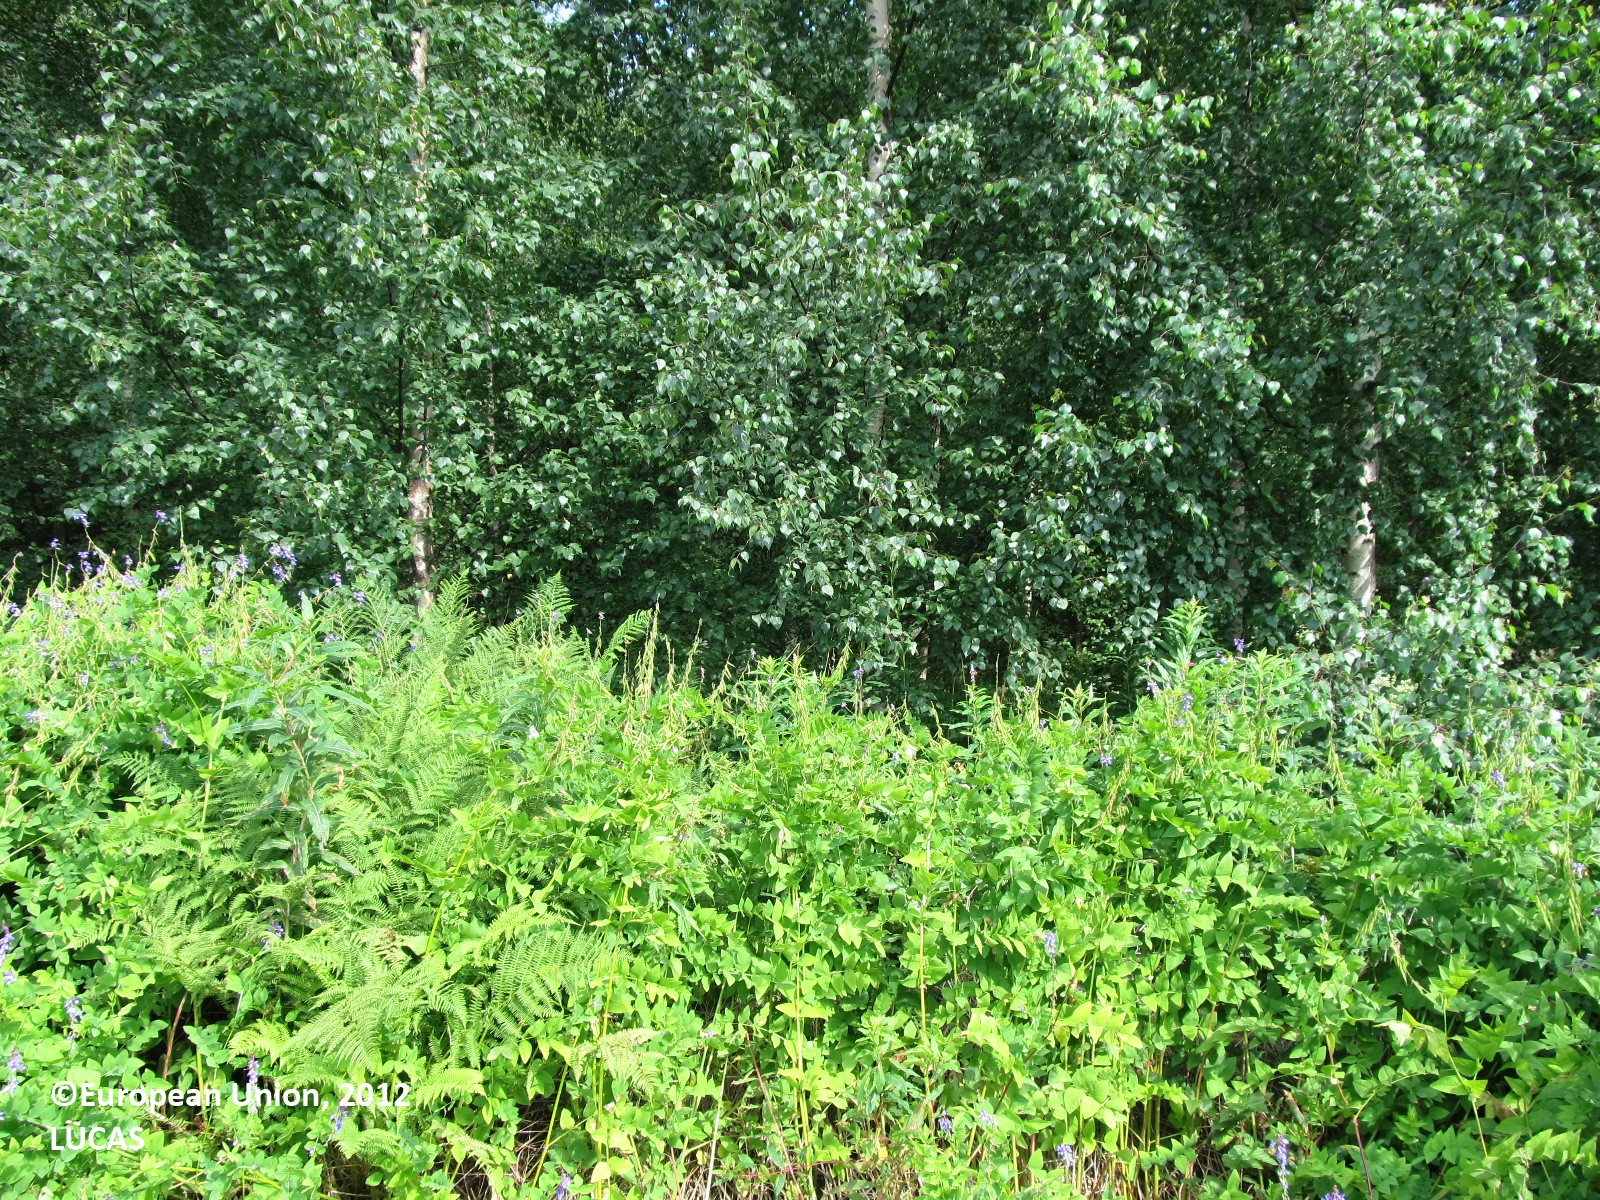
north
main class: Cropland
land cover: Oats
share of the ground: 50 - 75 %
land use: Agriculture (excluding fallow land and kitchen gardens)
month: July
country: FI
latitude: 61.9734
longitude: 28.6209
